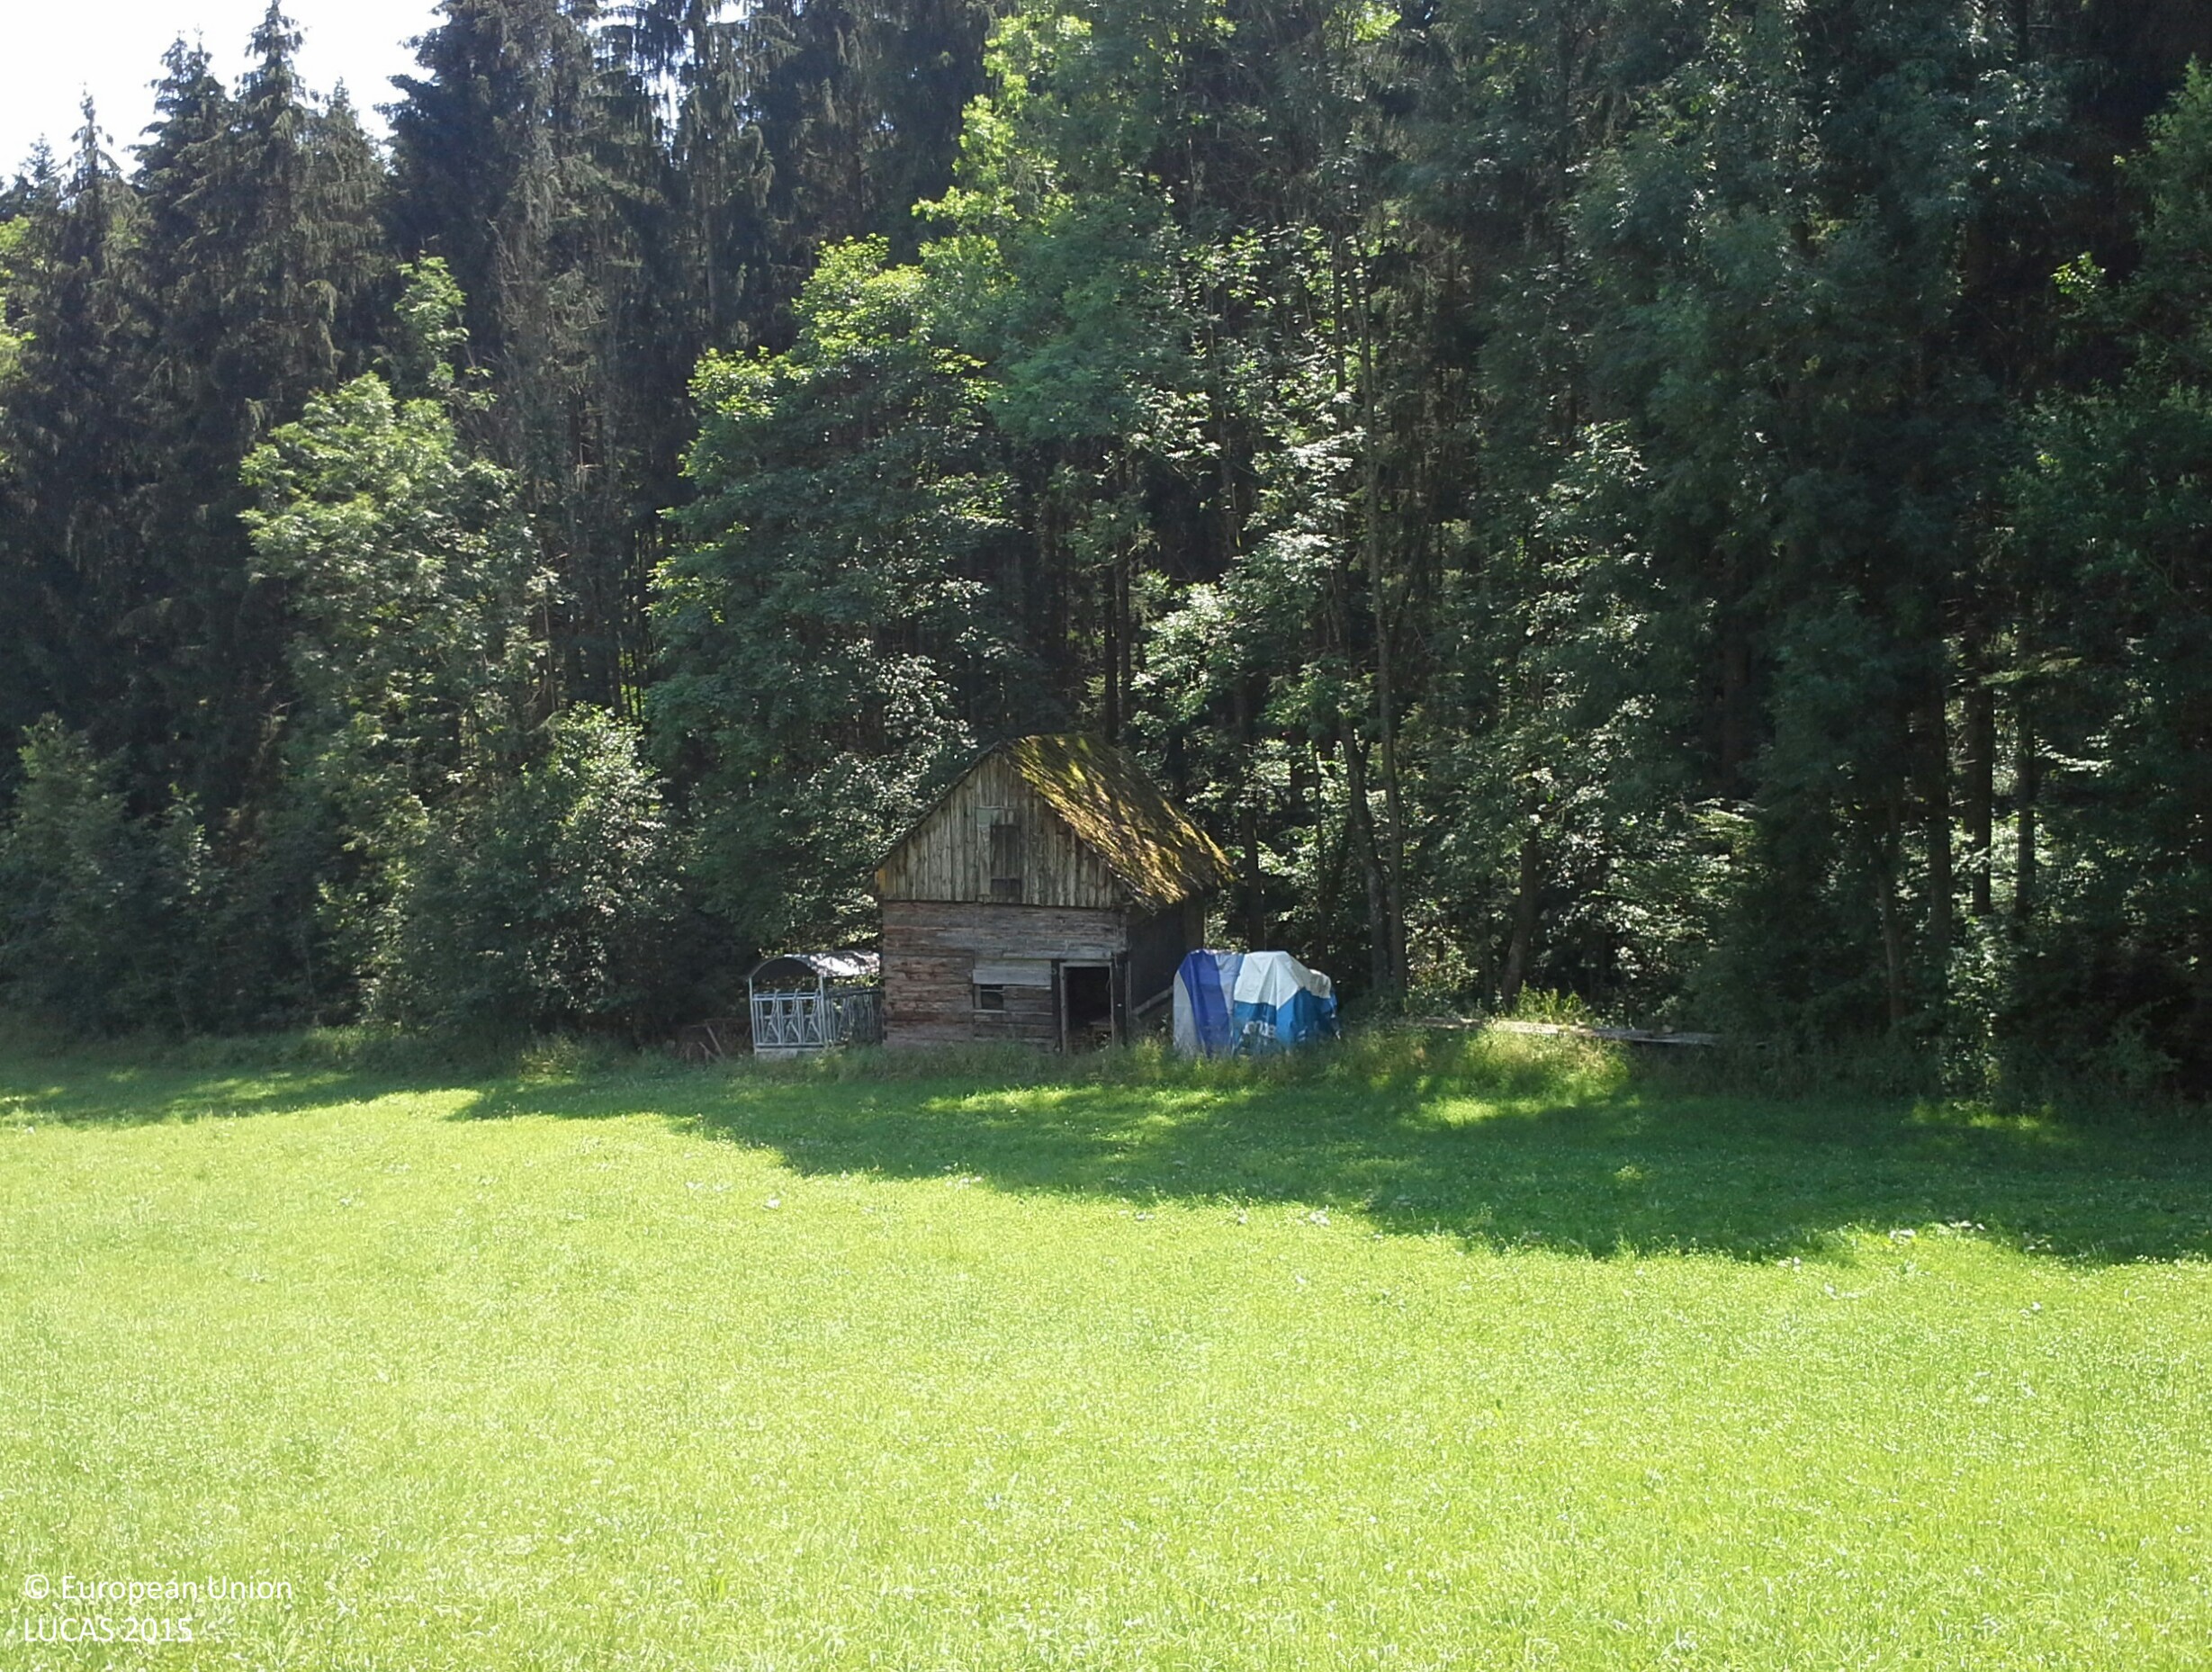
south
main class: Grassland
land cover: Grassland without tree/shrub cover
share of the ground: > 75 %
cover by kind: herbaceous plants 100 %
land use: Agriculture (excluding fallow land and kitchen gardens)
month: July
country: AT
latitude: 47.9790
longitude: 14.7027
